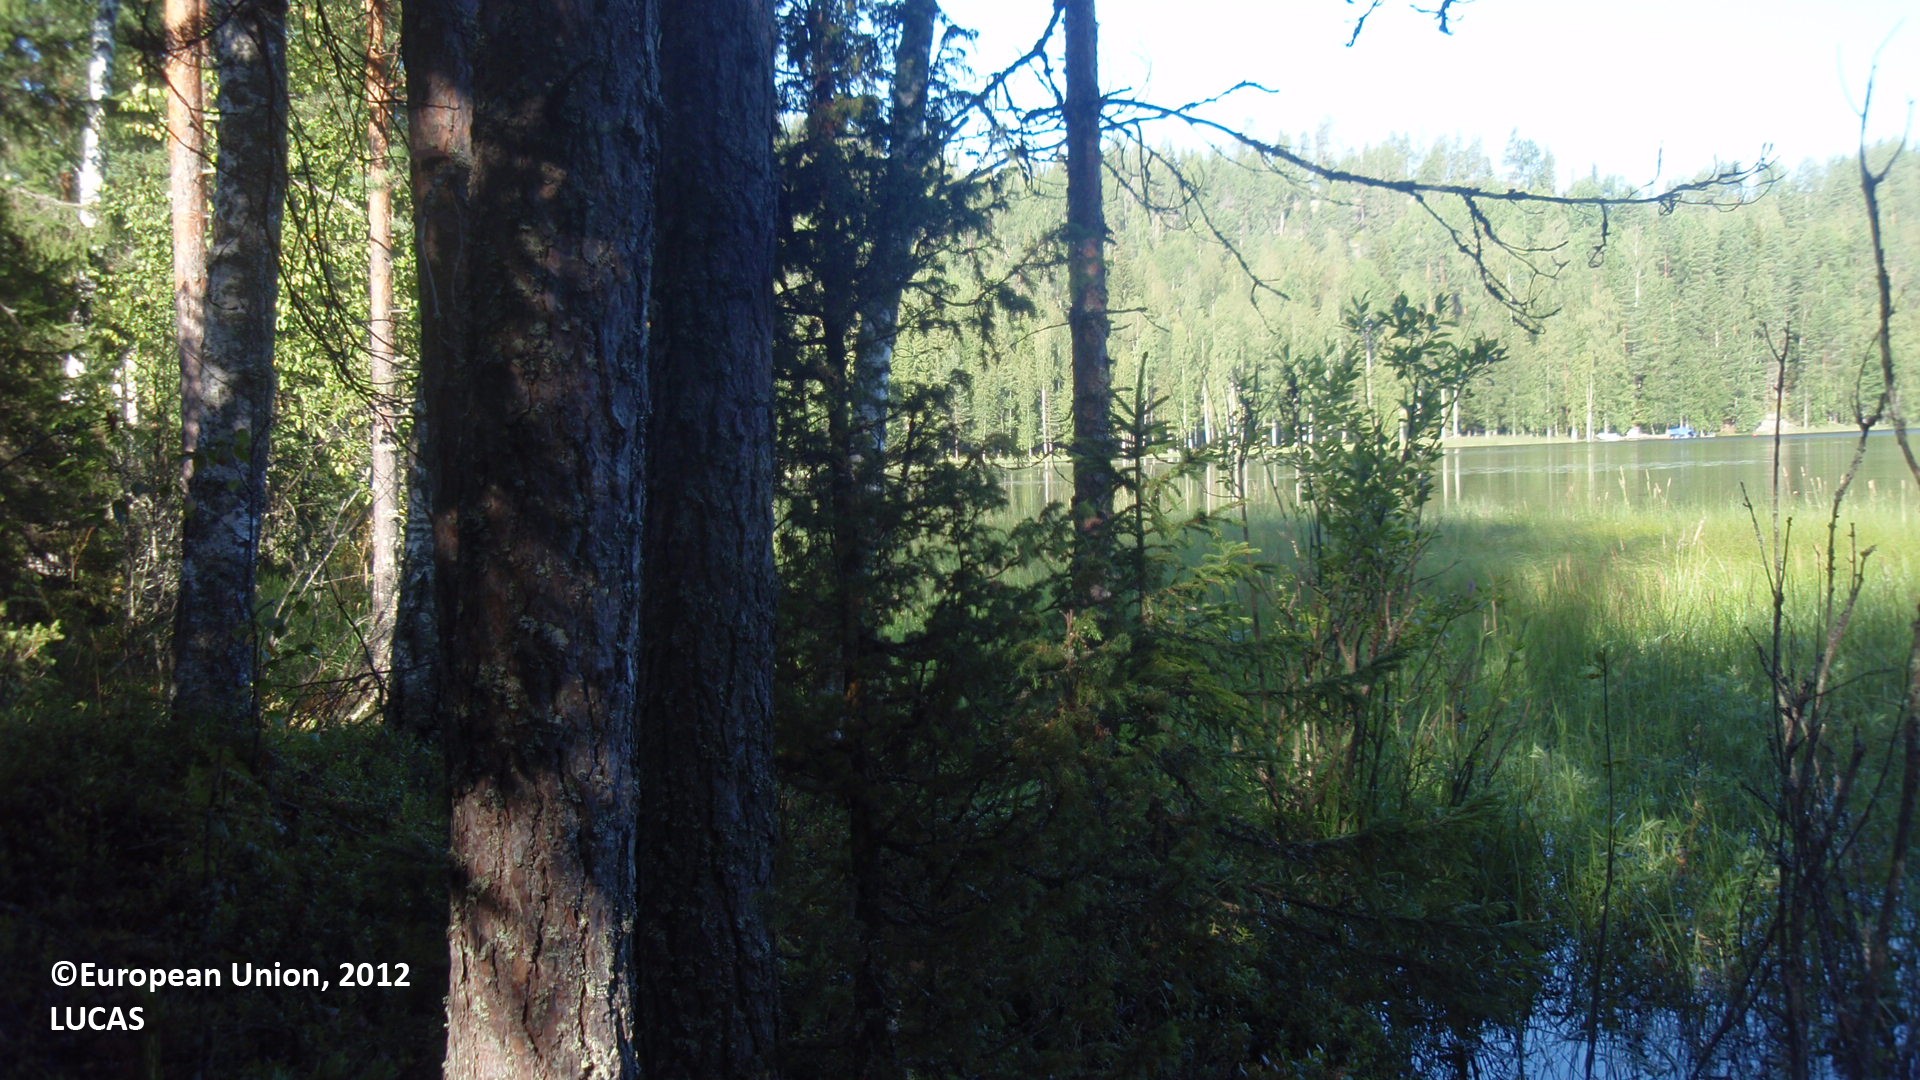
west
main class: Woodland
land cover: Broadleaved woodland
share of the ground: 50 - 75 %
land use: Forestry
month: August
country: FI
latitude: 61.5315
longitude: 27.8473
